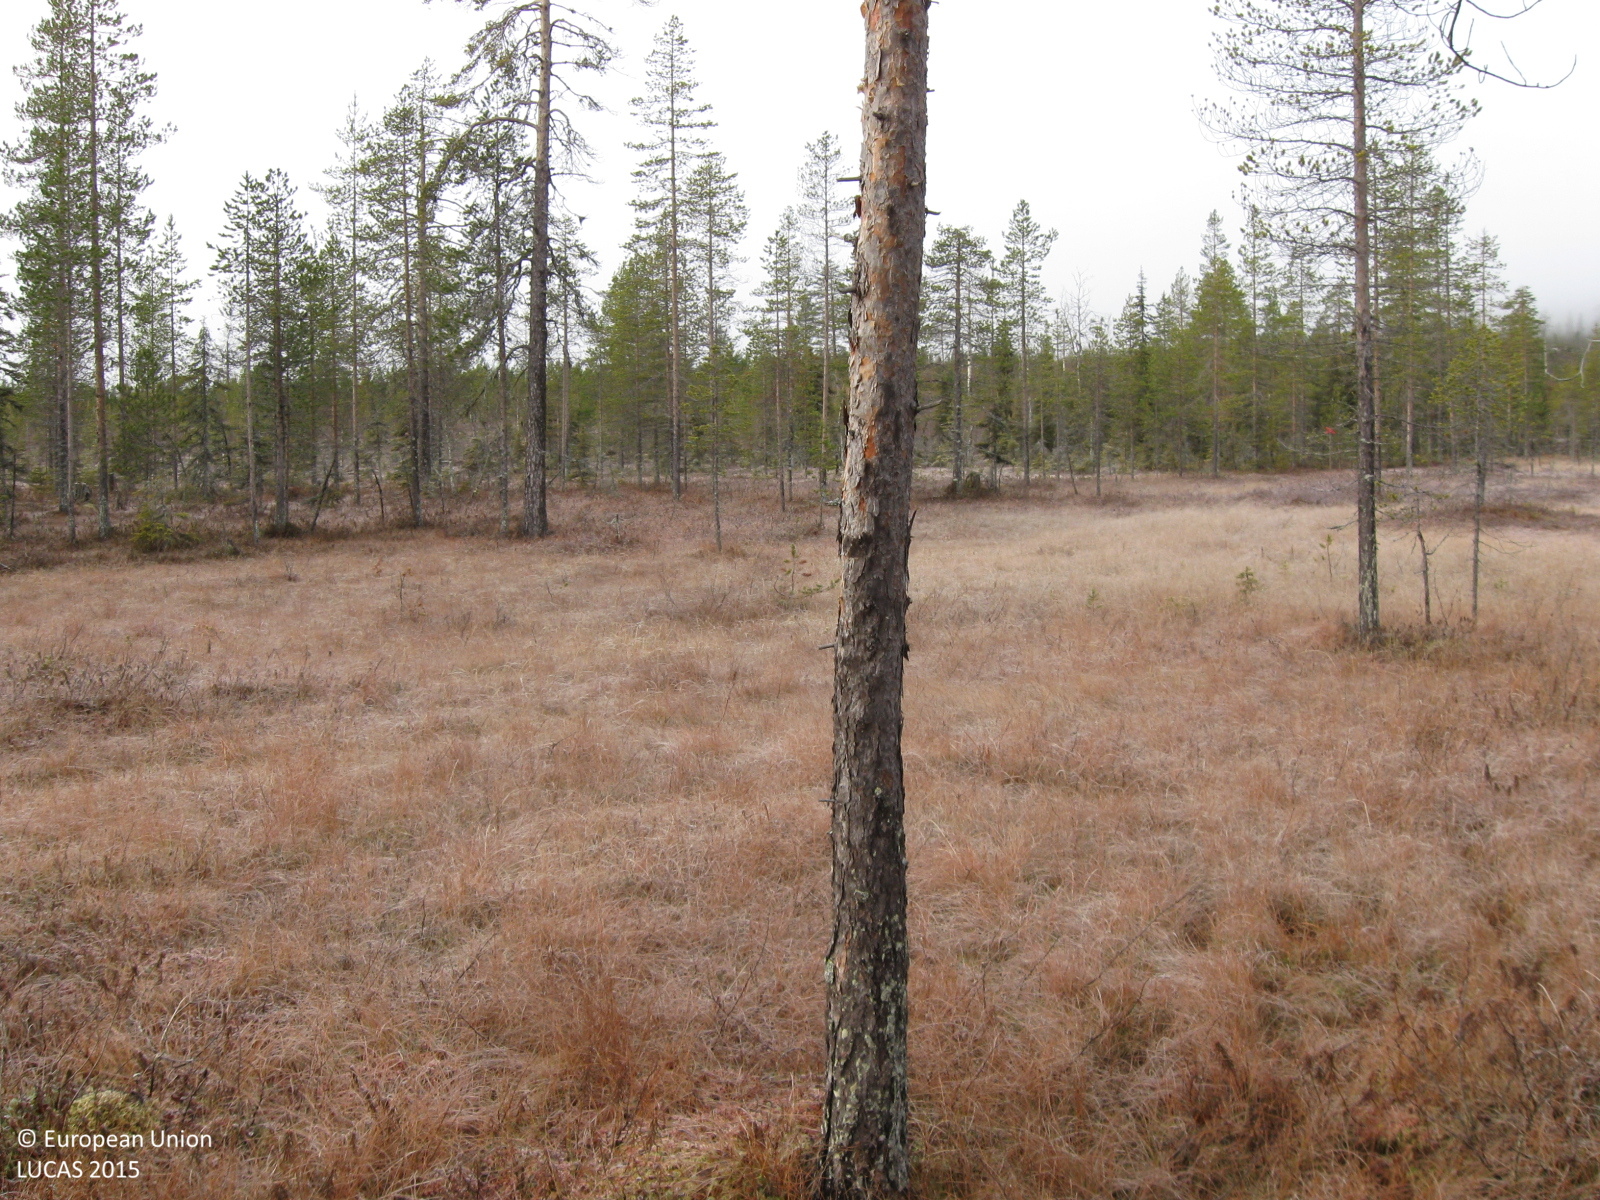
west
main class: Woodland
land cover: Pine dominated coniferous woodland
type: mire and swamp forests
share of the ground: 25 - 50 %
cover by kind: coniferous forest trees 35 %, herbaceous plants 30 %, shrubs 15 %, broadleaved forest trees 10 %, lichens and mosses 10 %
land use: Forestry
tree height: > 5 m
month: October
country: SE
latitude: 66.5031
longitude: 21.5383
